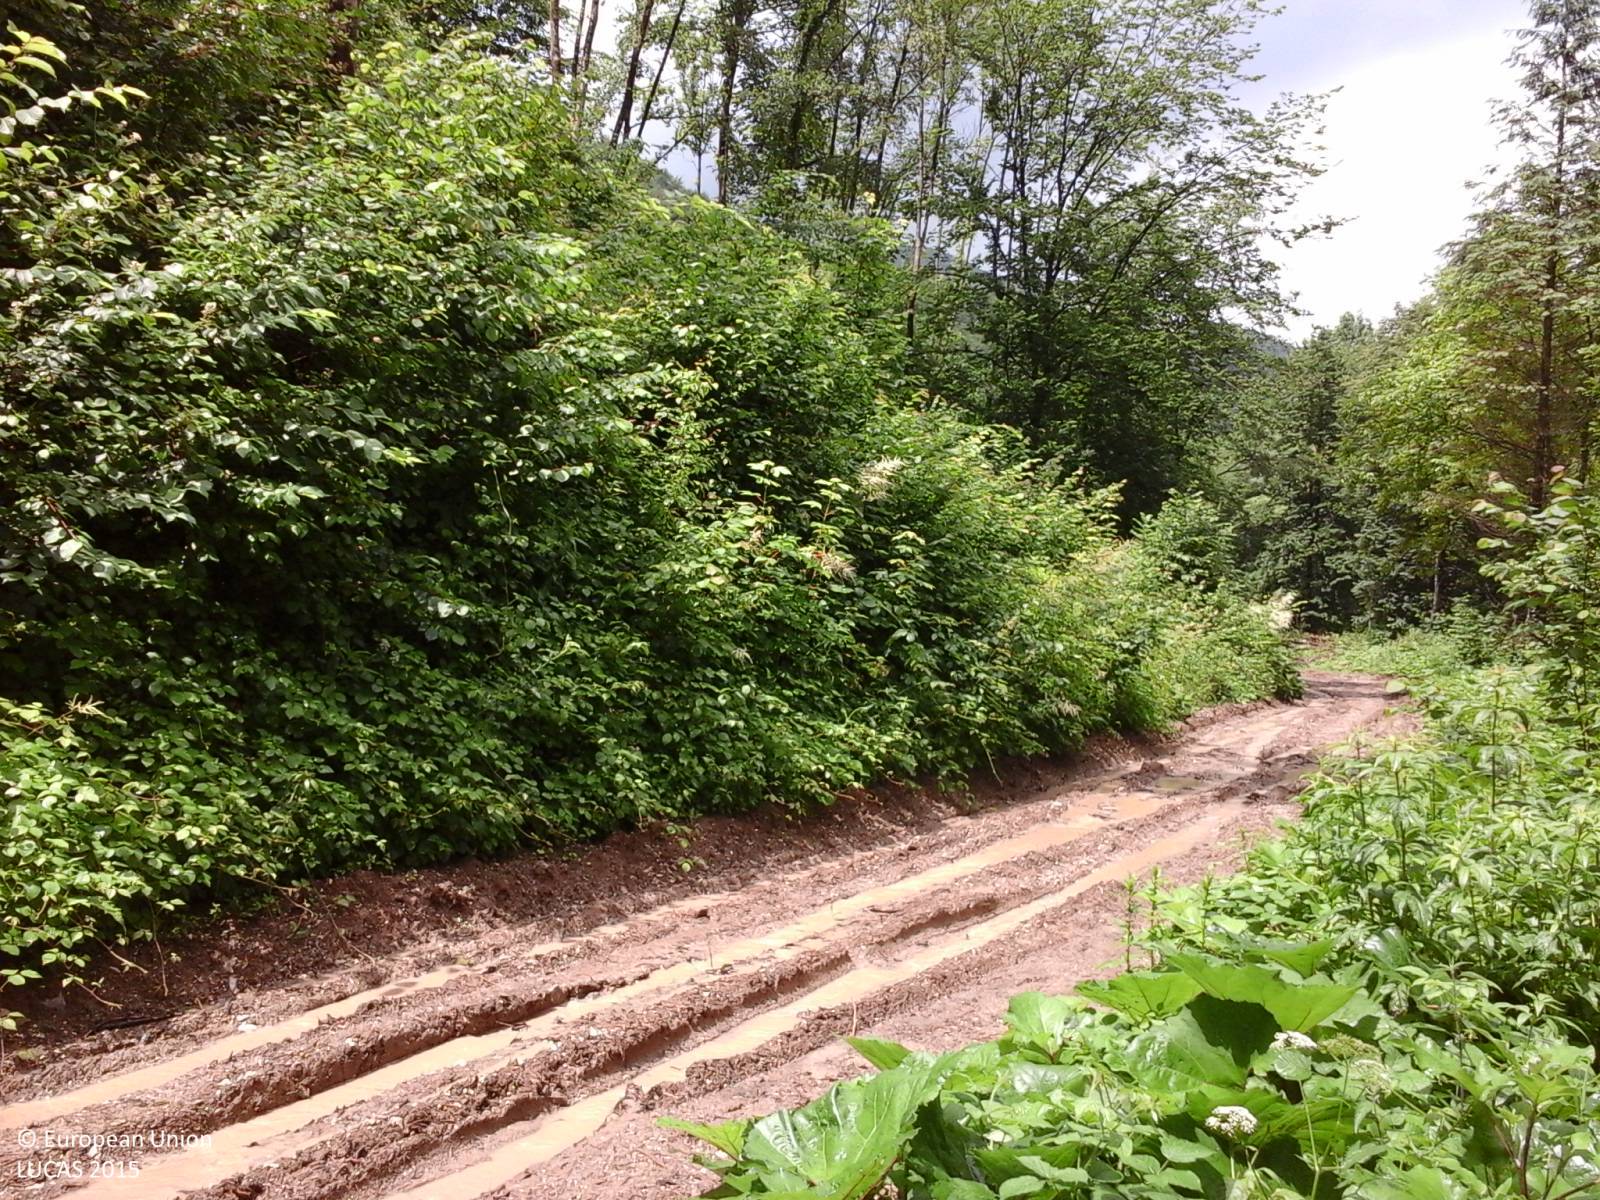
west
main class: Woodland
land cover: Broadleaved woodland
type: thermophilous deciduous forest
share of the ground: > 75 %
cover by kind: broadleaved forest trees 70 %, coniferous forest trees 10 %, shrubs 10 %, herbaceous plants 10 %
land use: Forestry
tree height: > 5 m
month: June
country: IT
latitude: 46.2453
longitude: 13.3299
